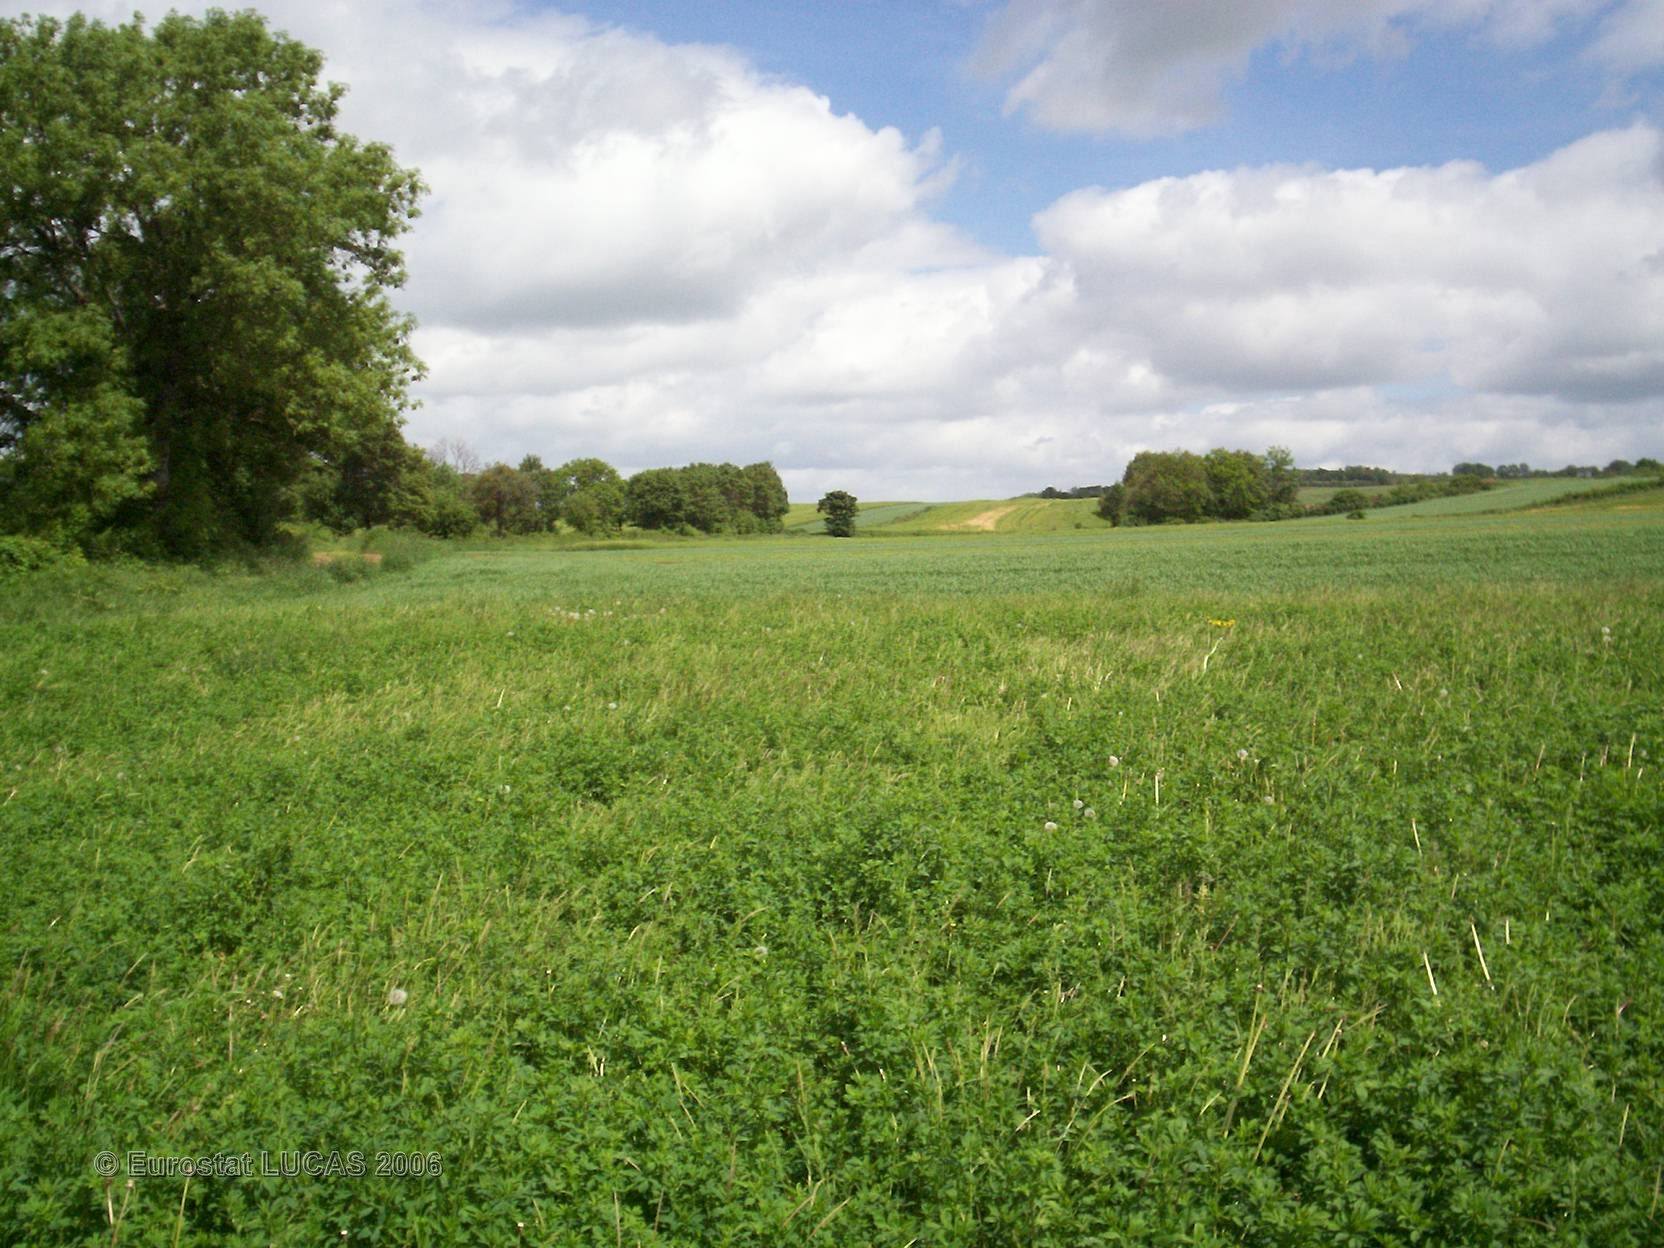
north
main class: Cropland
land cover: Lucerne
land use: Agriculture (excluding fallow land and kitchen gardens)
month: May
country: FR
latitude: 47.0471
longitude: 4.6431
